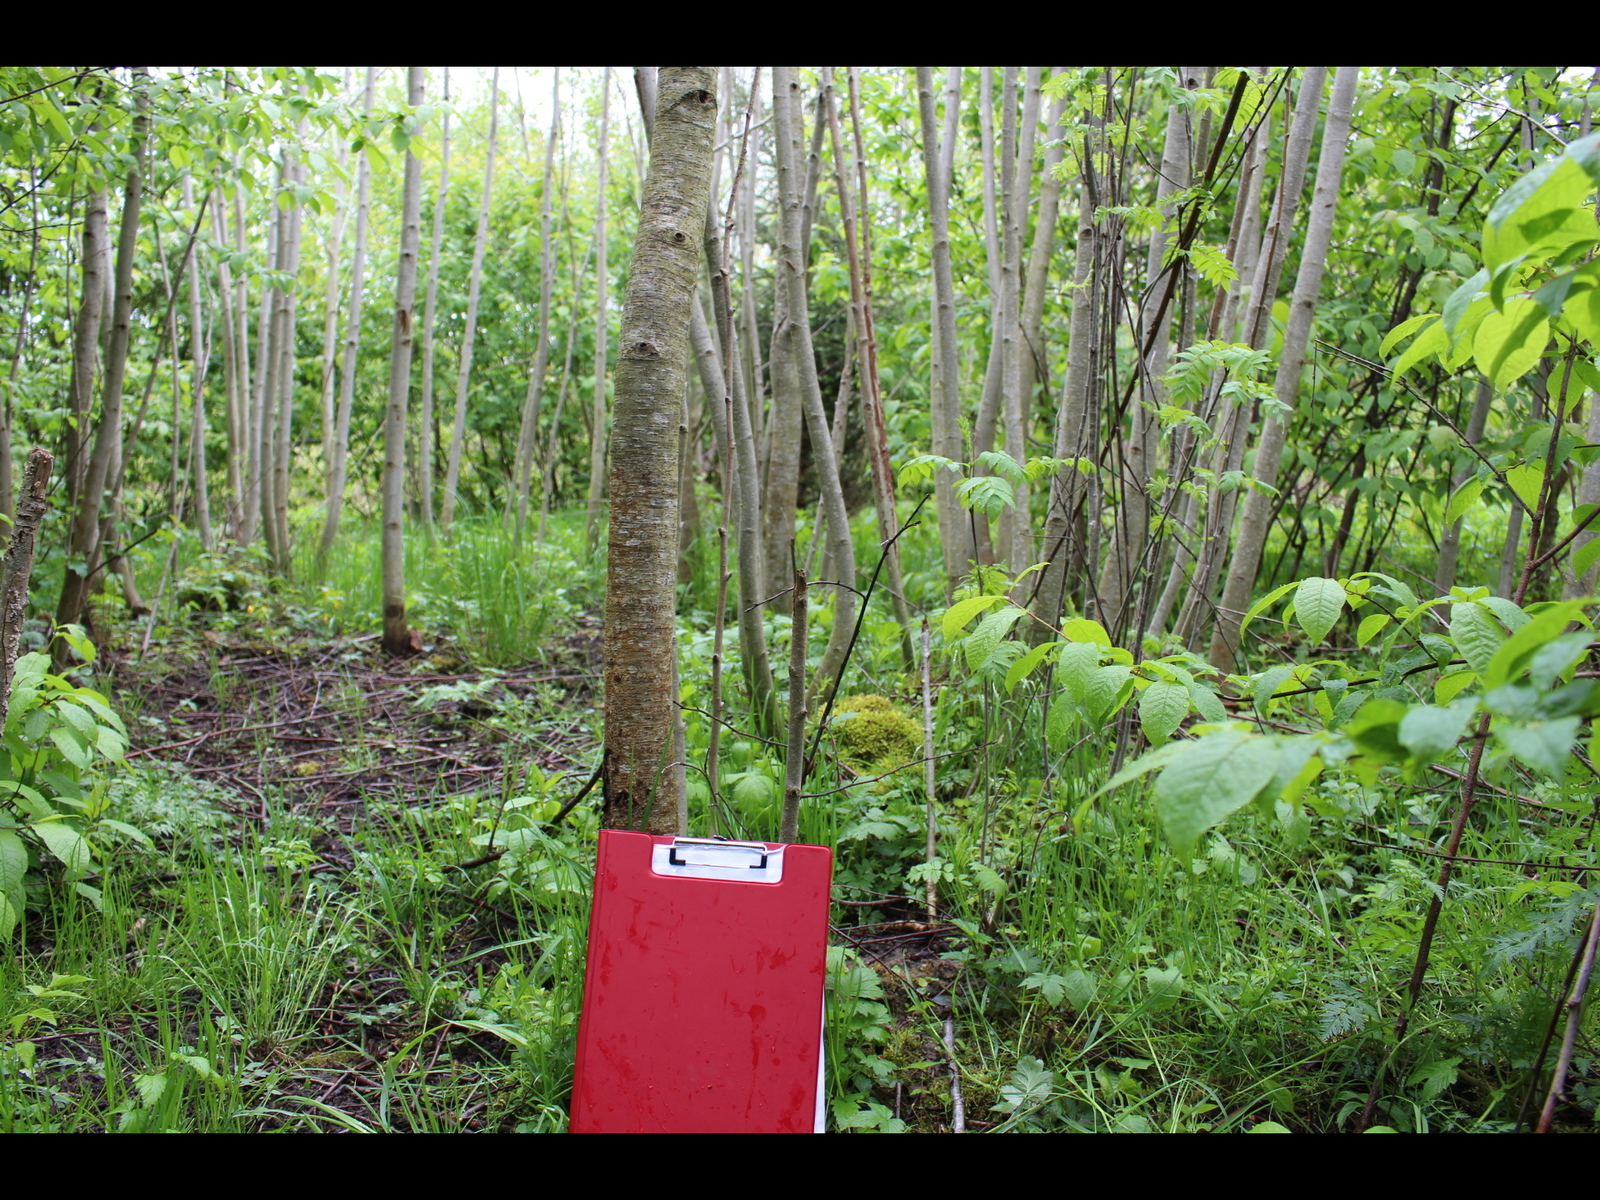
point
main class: Woodland
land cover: Broadleaved woodland
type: non-riverine alder, birch or aspen forest
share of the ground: > 75 %
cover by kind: broadleaved forest trees 95 %, herbaceous plants 5 %
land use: Forestry
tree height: < 5 m
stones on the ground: < 10 %
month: May
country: LV
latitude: 56.8319
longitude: 22.8616
